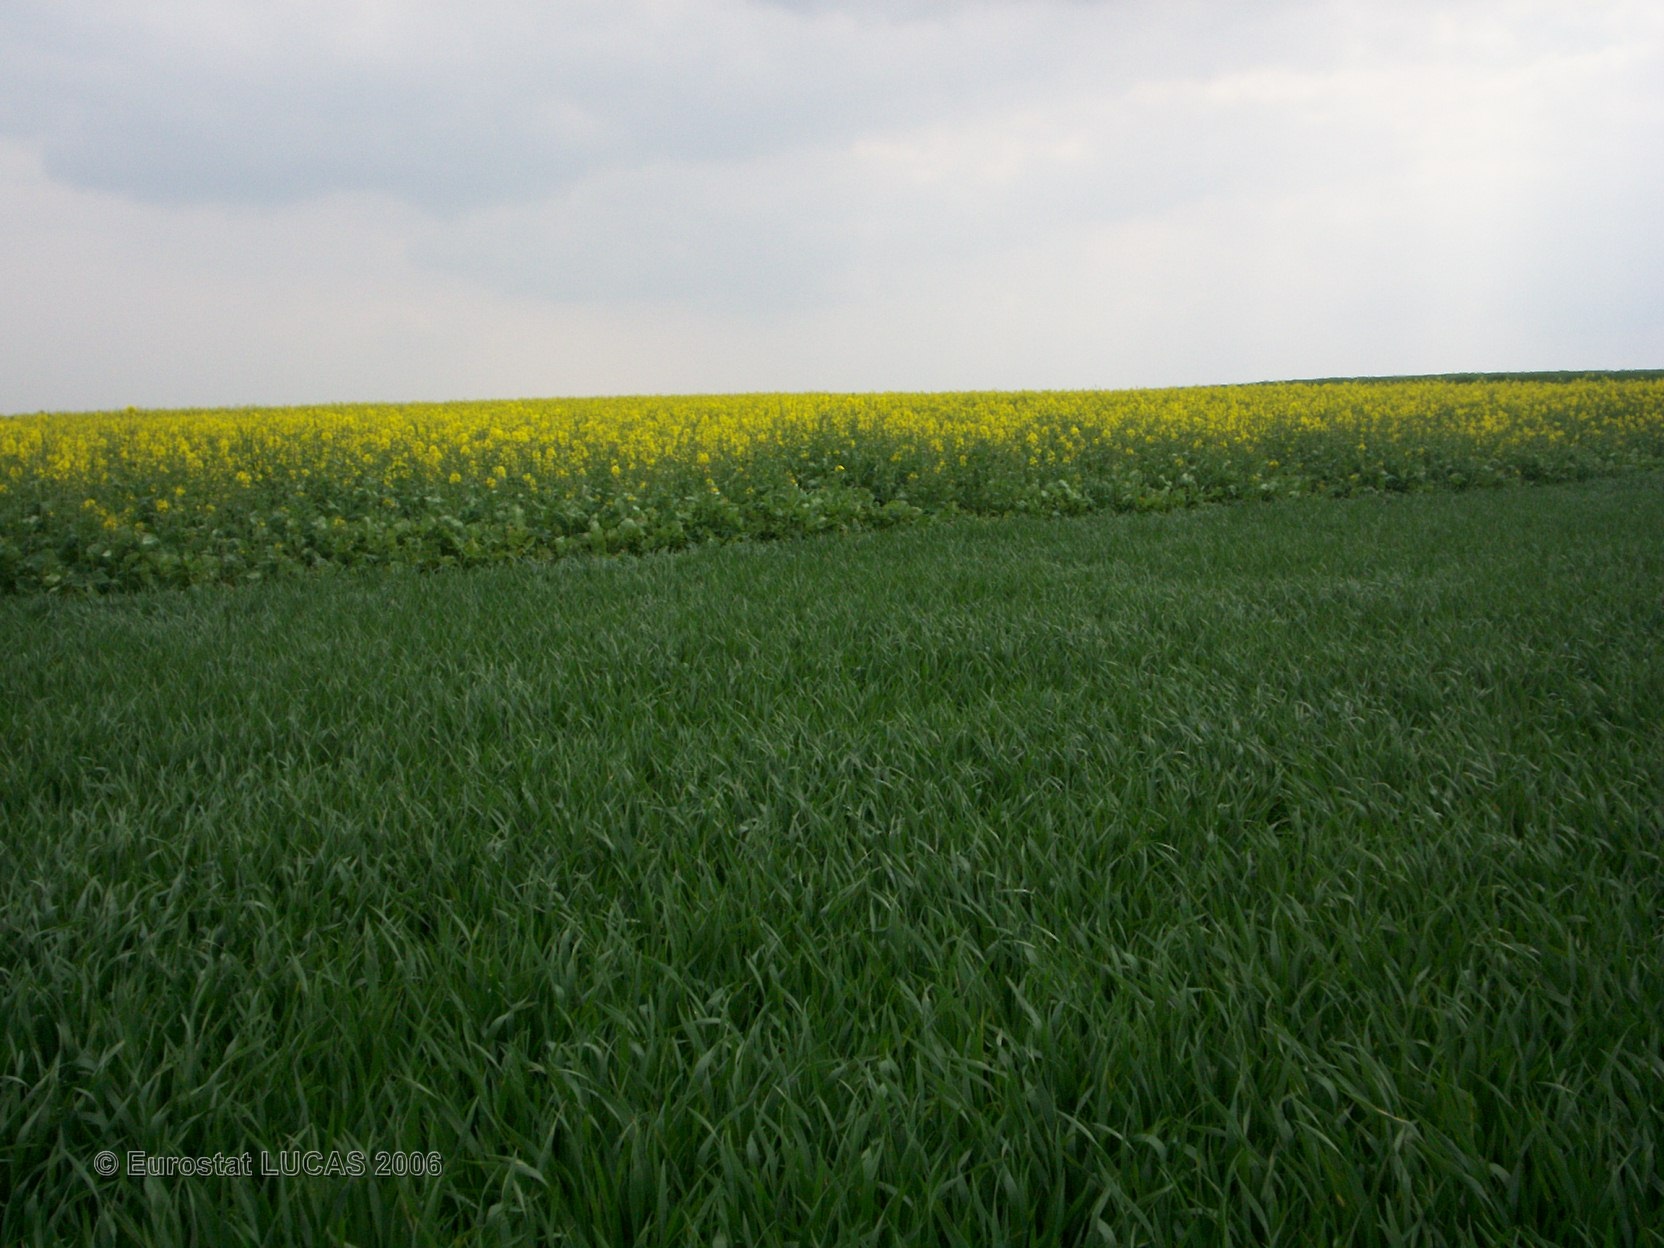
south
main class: Cropland
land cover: Common wheat
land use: Agriculture (excluding fallow land and kitchen gardens)
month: April
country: FR
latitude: 47.1727
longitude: 3.0423
